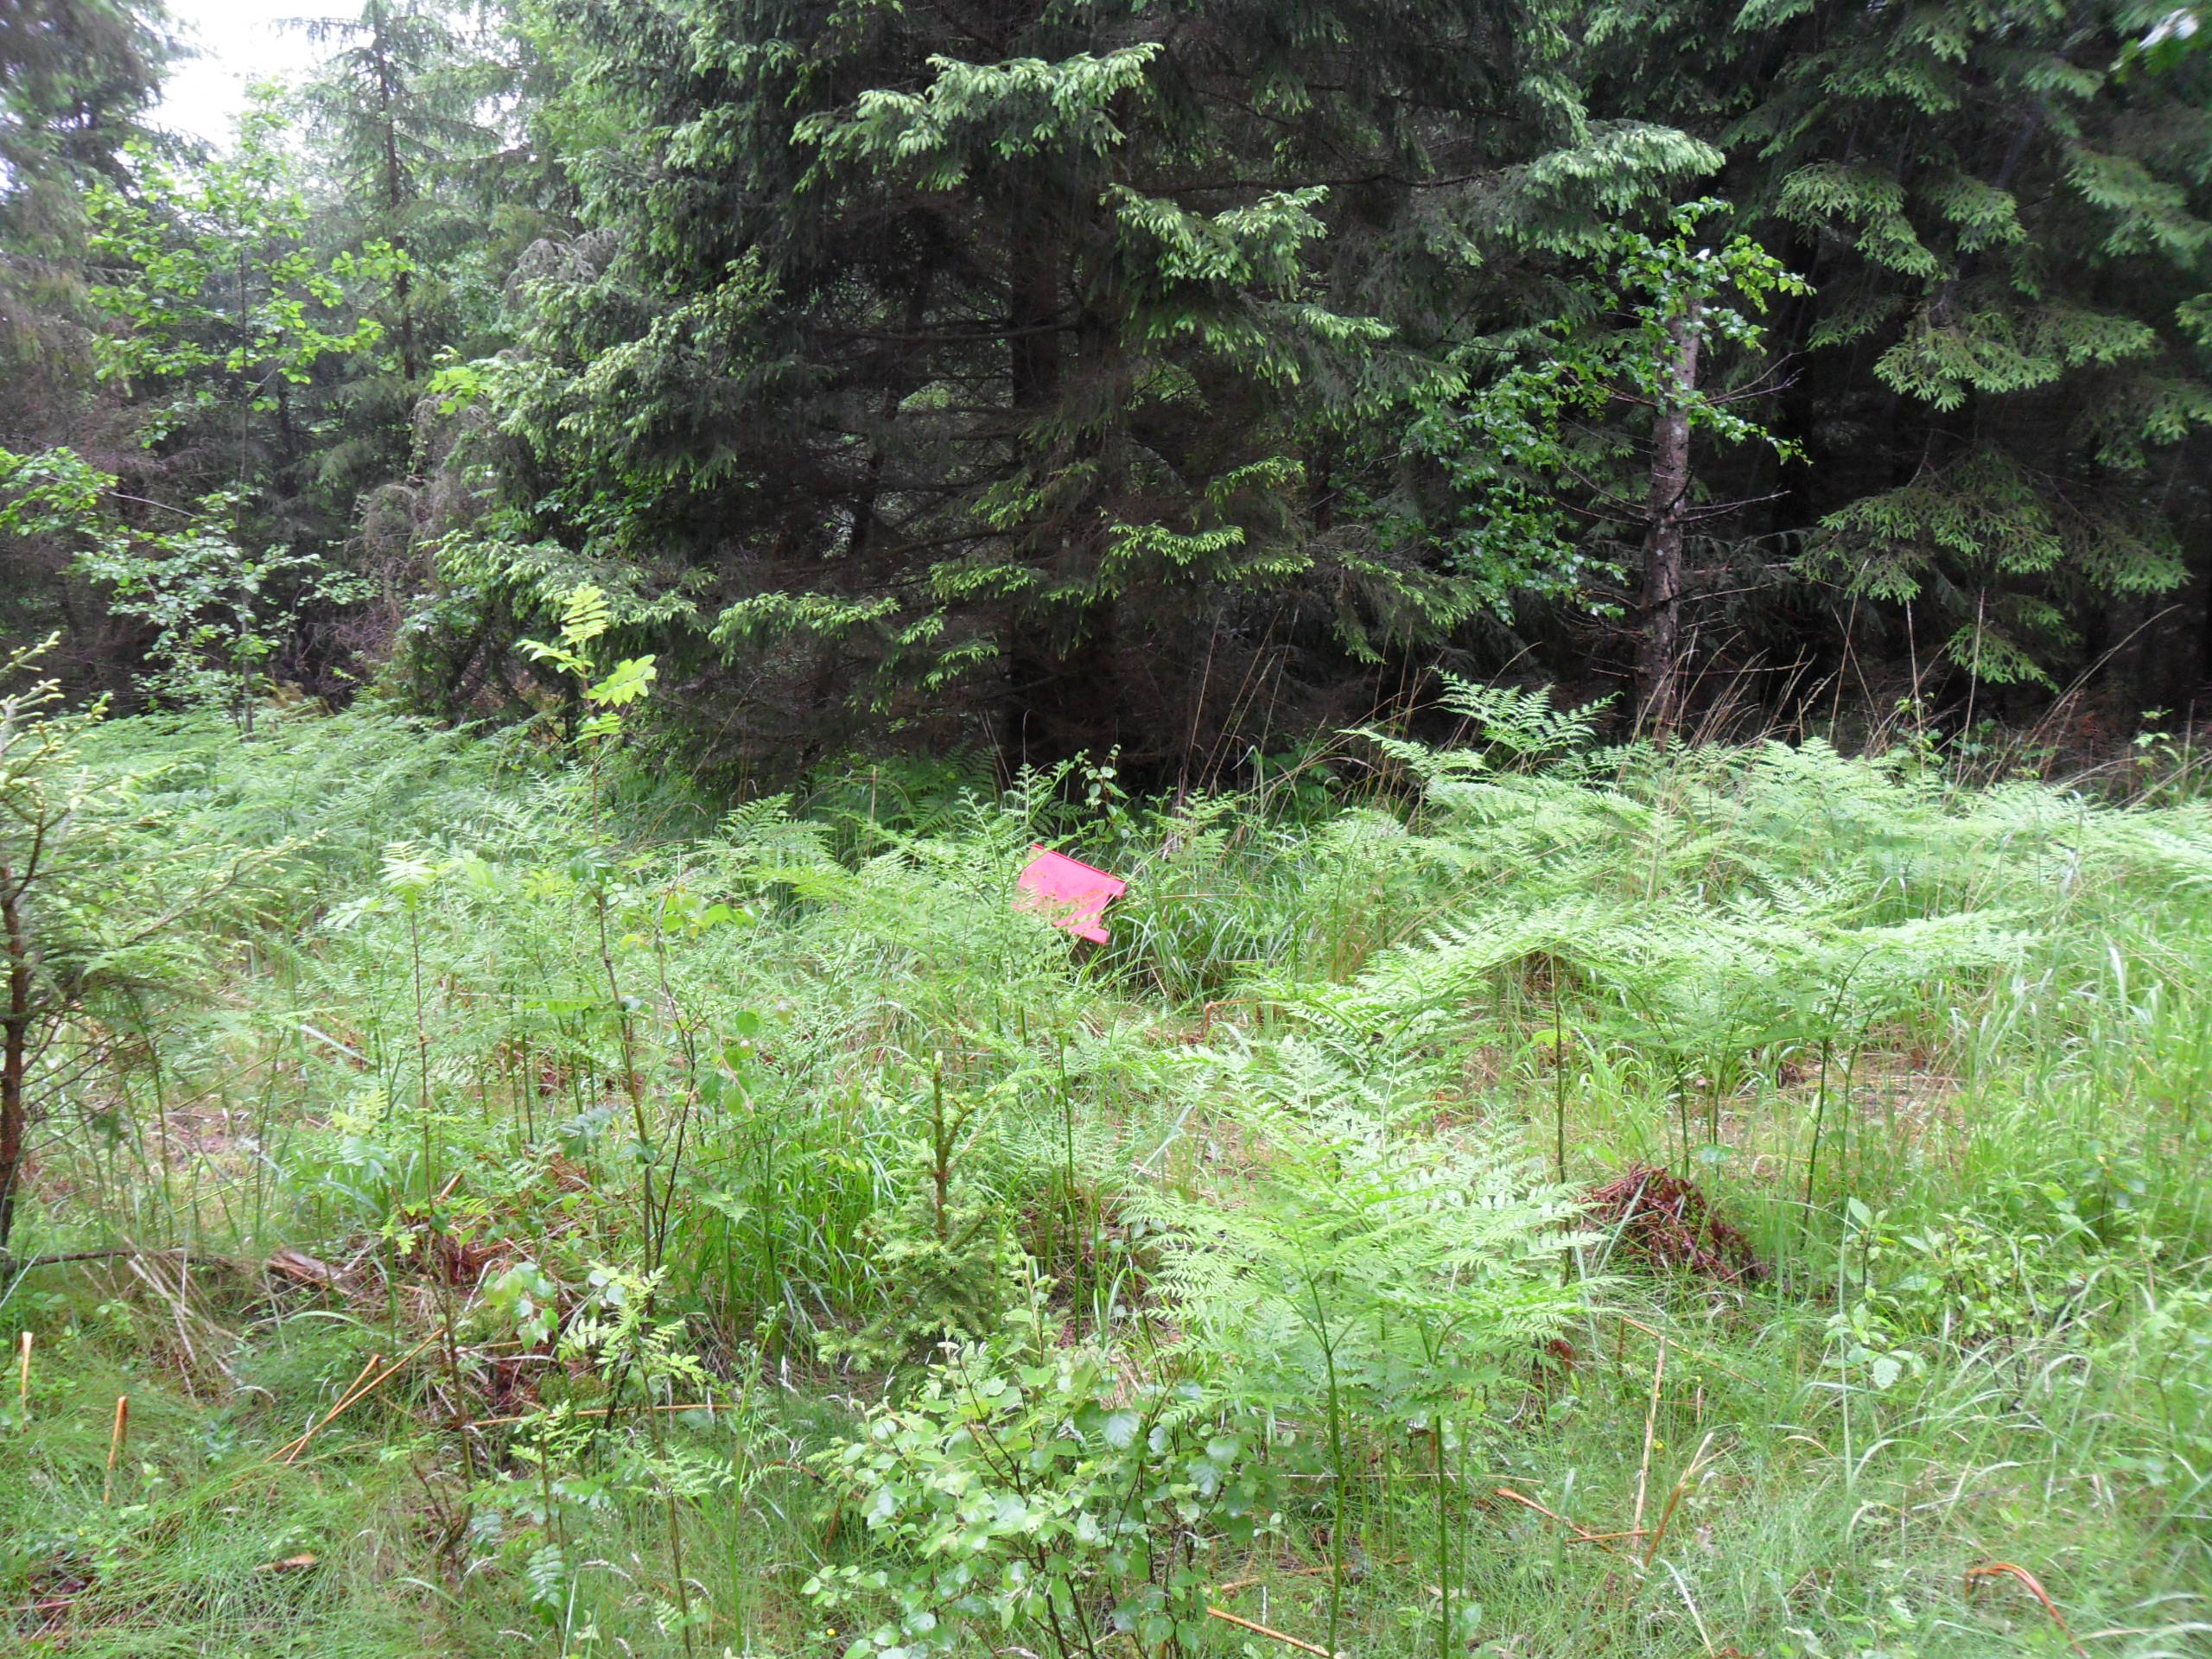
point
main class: Woodland
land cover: Spruce dominated coniferous woodland
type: hemiboreal forest and nemoral coniferous forest and mixed broadleaved-coniferous forest
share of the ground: > 75 %
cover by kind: coniferous forest trees 80 %, herbaceous plants 15 %, shrubs 5 %
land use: Forestry
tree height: > 5 m
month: June
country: LV
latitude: 57.3284
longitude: 22.0552
